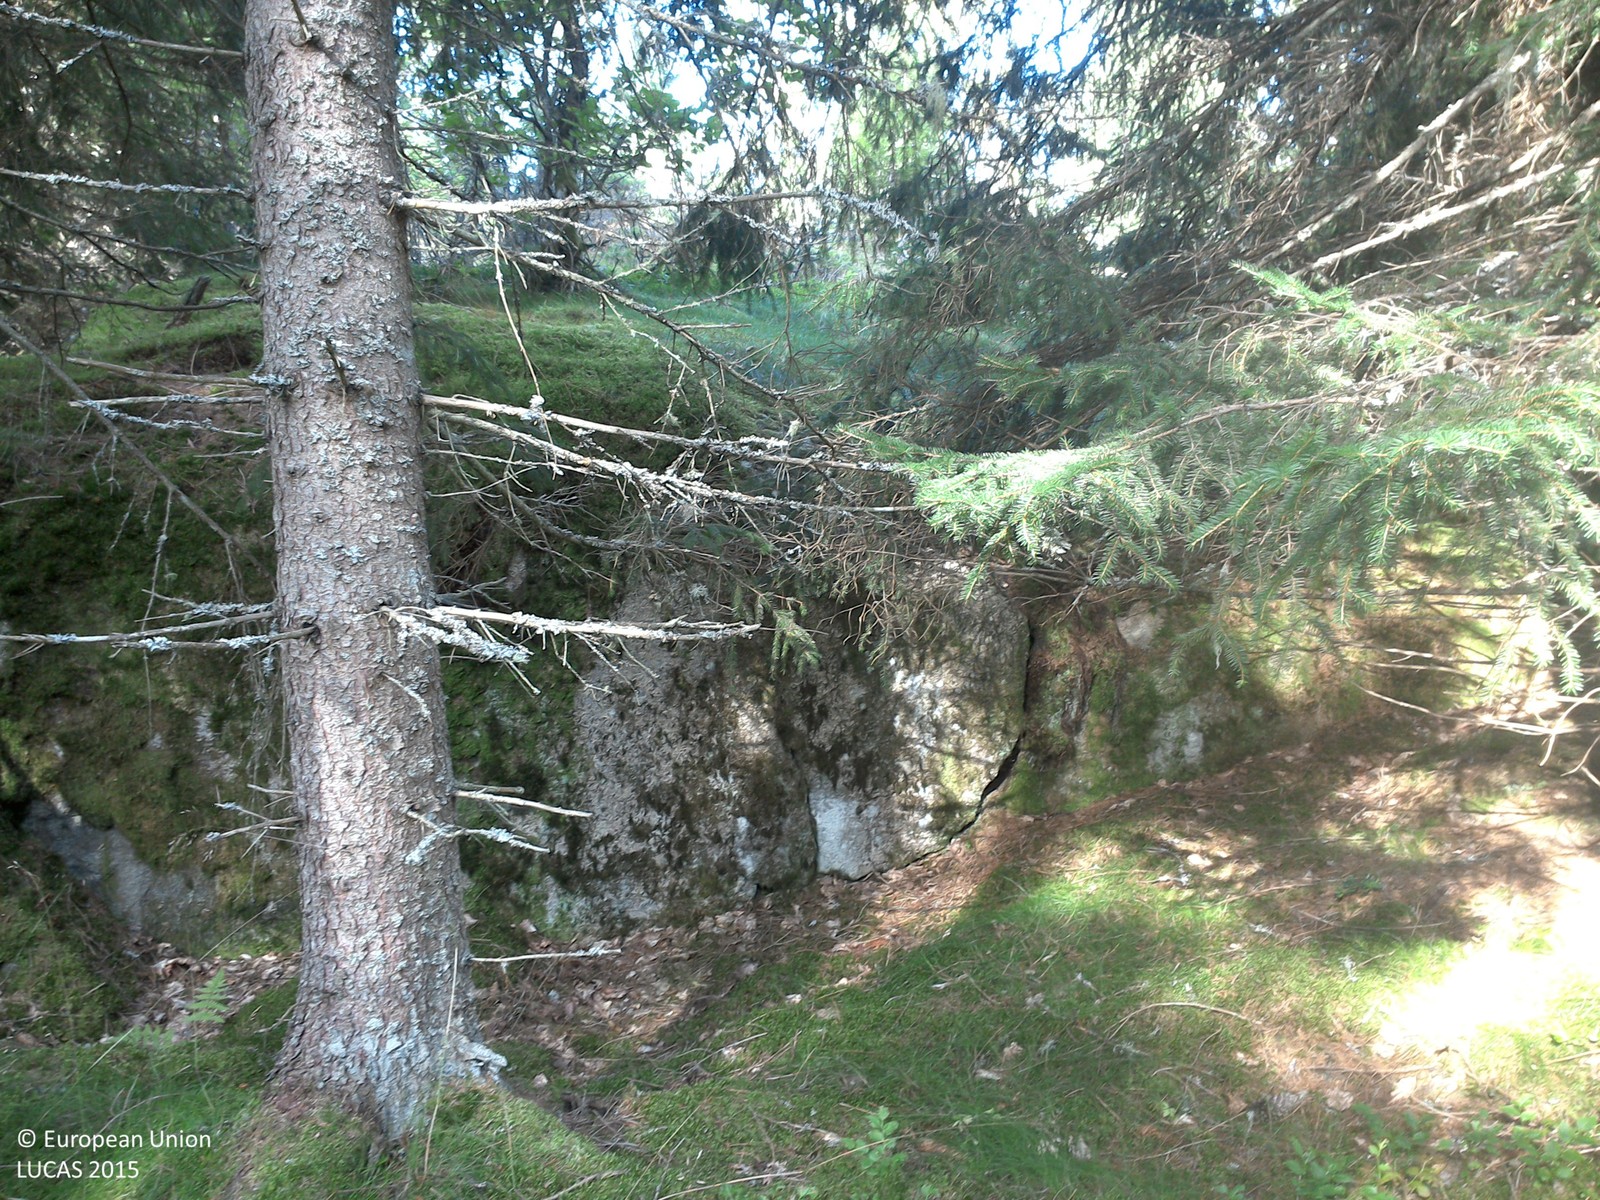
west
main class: Woodland
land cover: Spruce dominated coniferous woodland
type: boreal forest
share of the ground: 50 - 75 %
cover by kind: coniferous forest trees 55 %, lichens and mosses 45 %
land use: Forestry
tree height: > 5 m
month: August
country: SE
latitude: 58.2378
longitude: 14.9166
